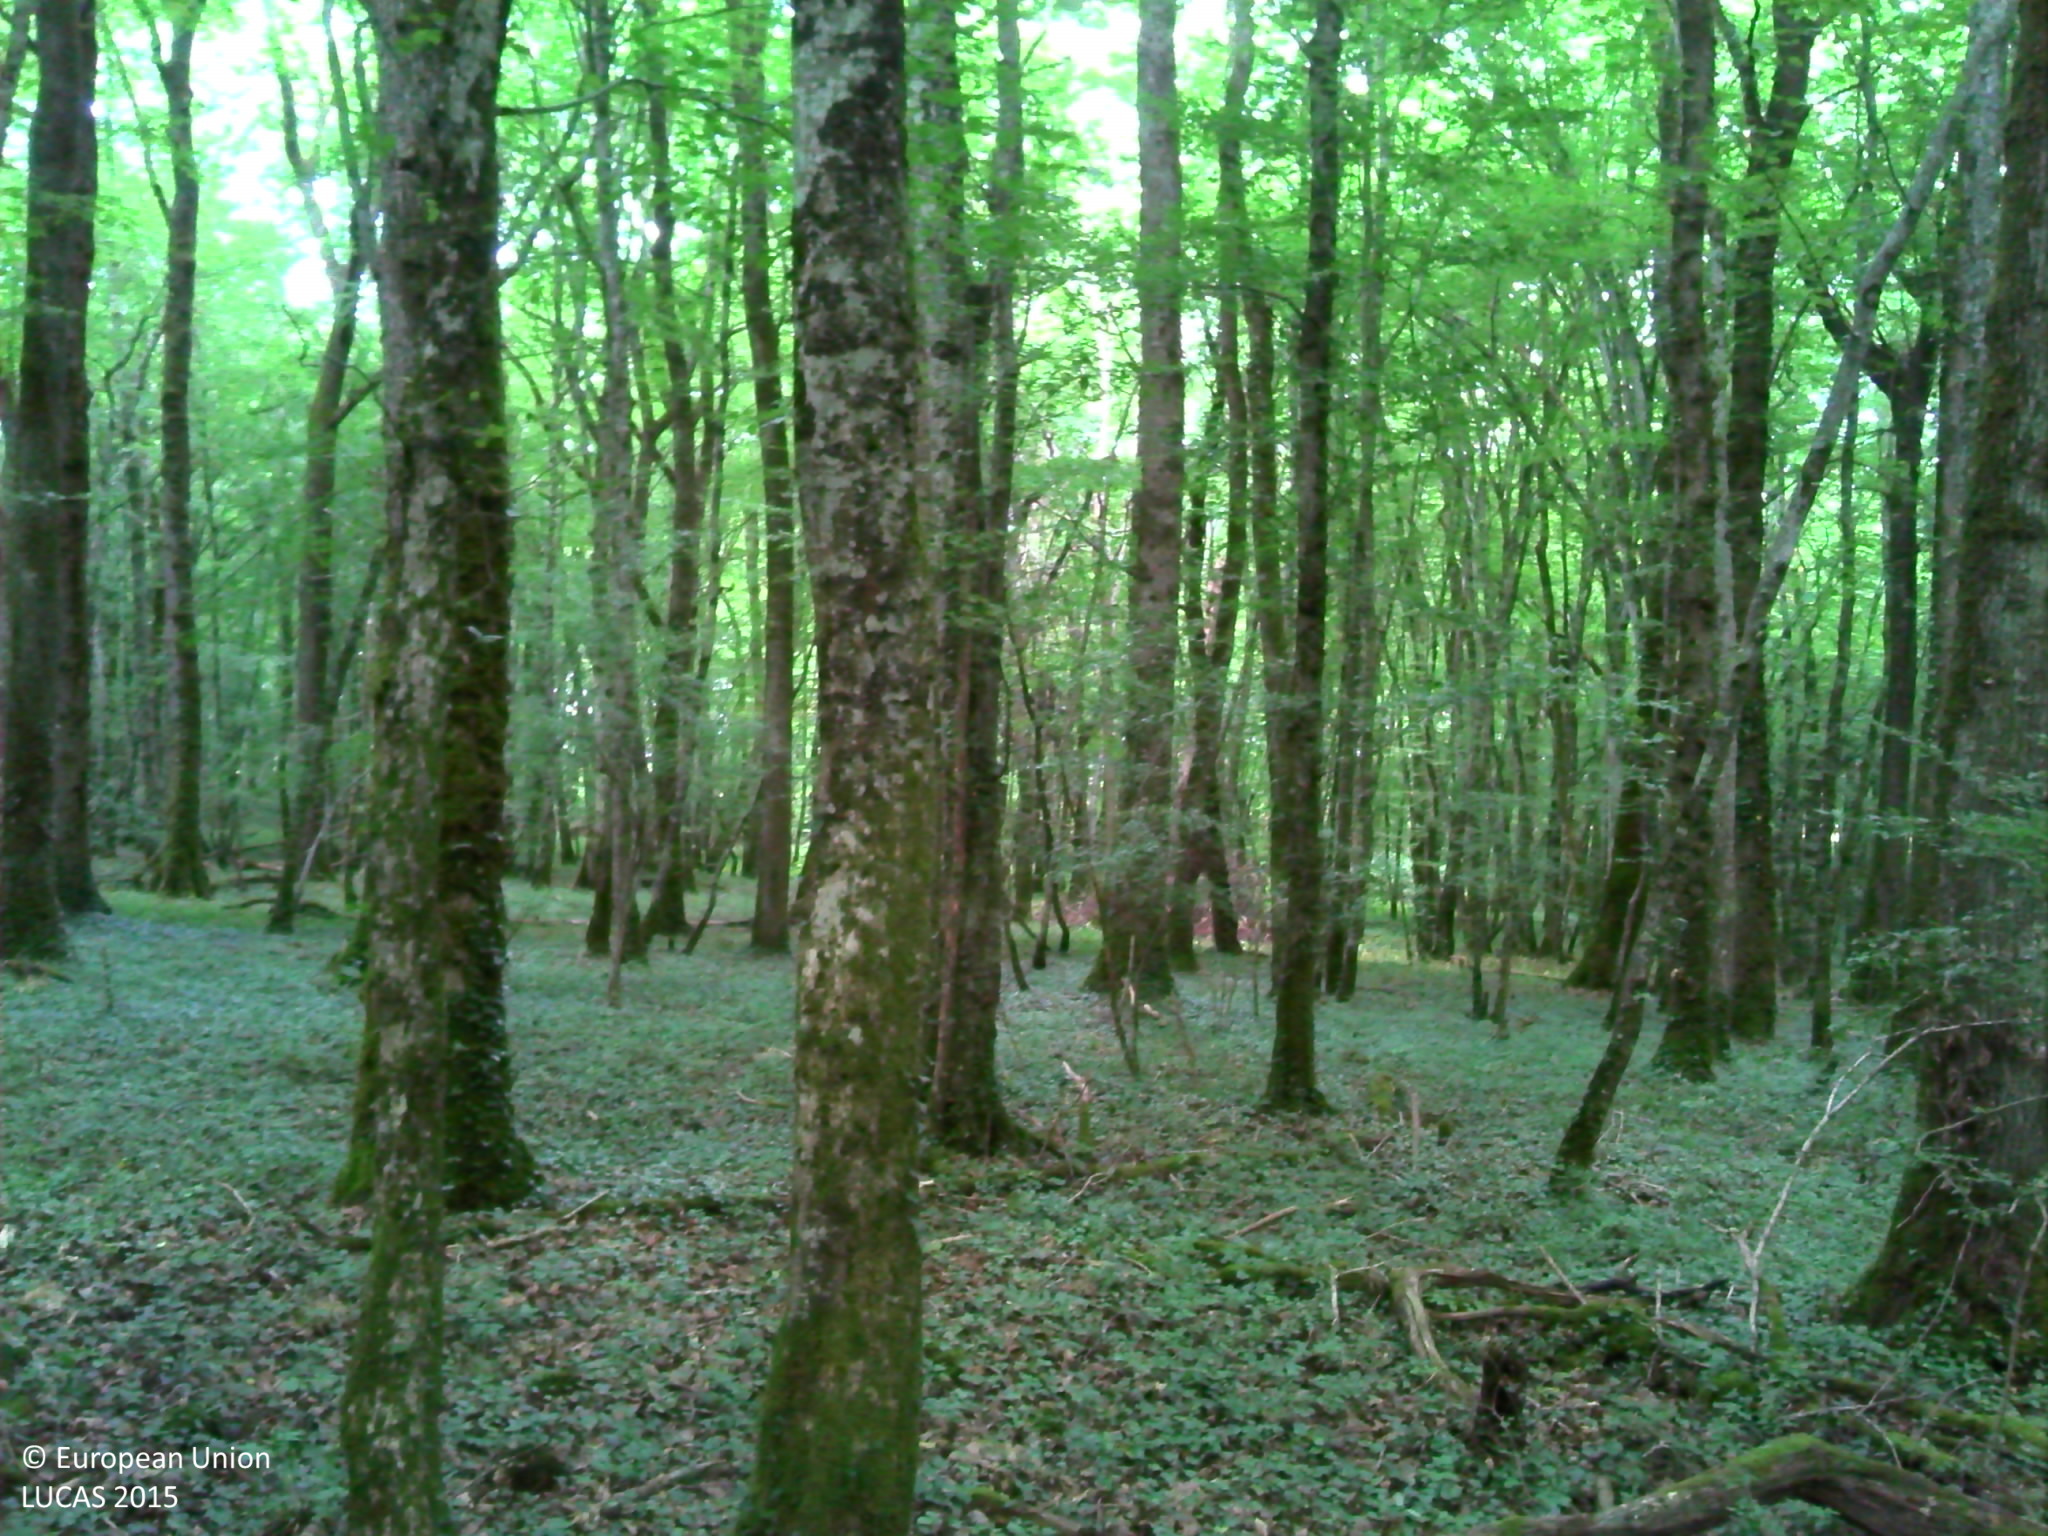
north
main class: Woodland
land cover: Broadleaved woodland
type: beech forest
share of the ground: > 75 %
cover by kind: broadleaved forest trees 90 %, herbaceous plants 10 %
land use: Forestry
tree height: > 5 m
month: July
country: FR
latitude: 47.3158
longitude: 3.6074
